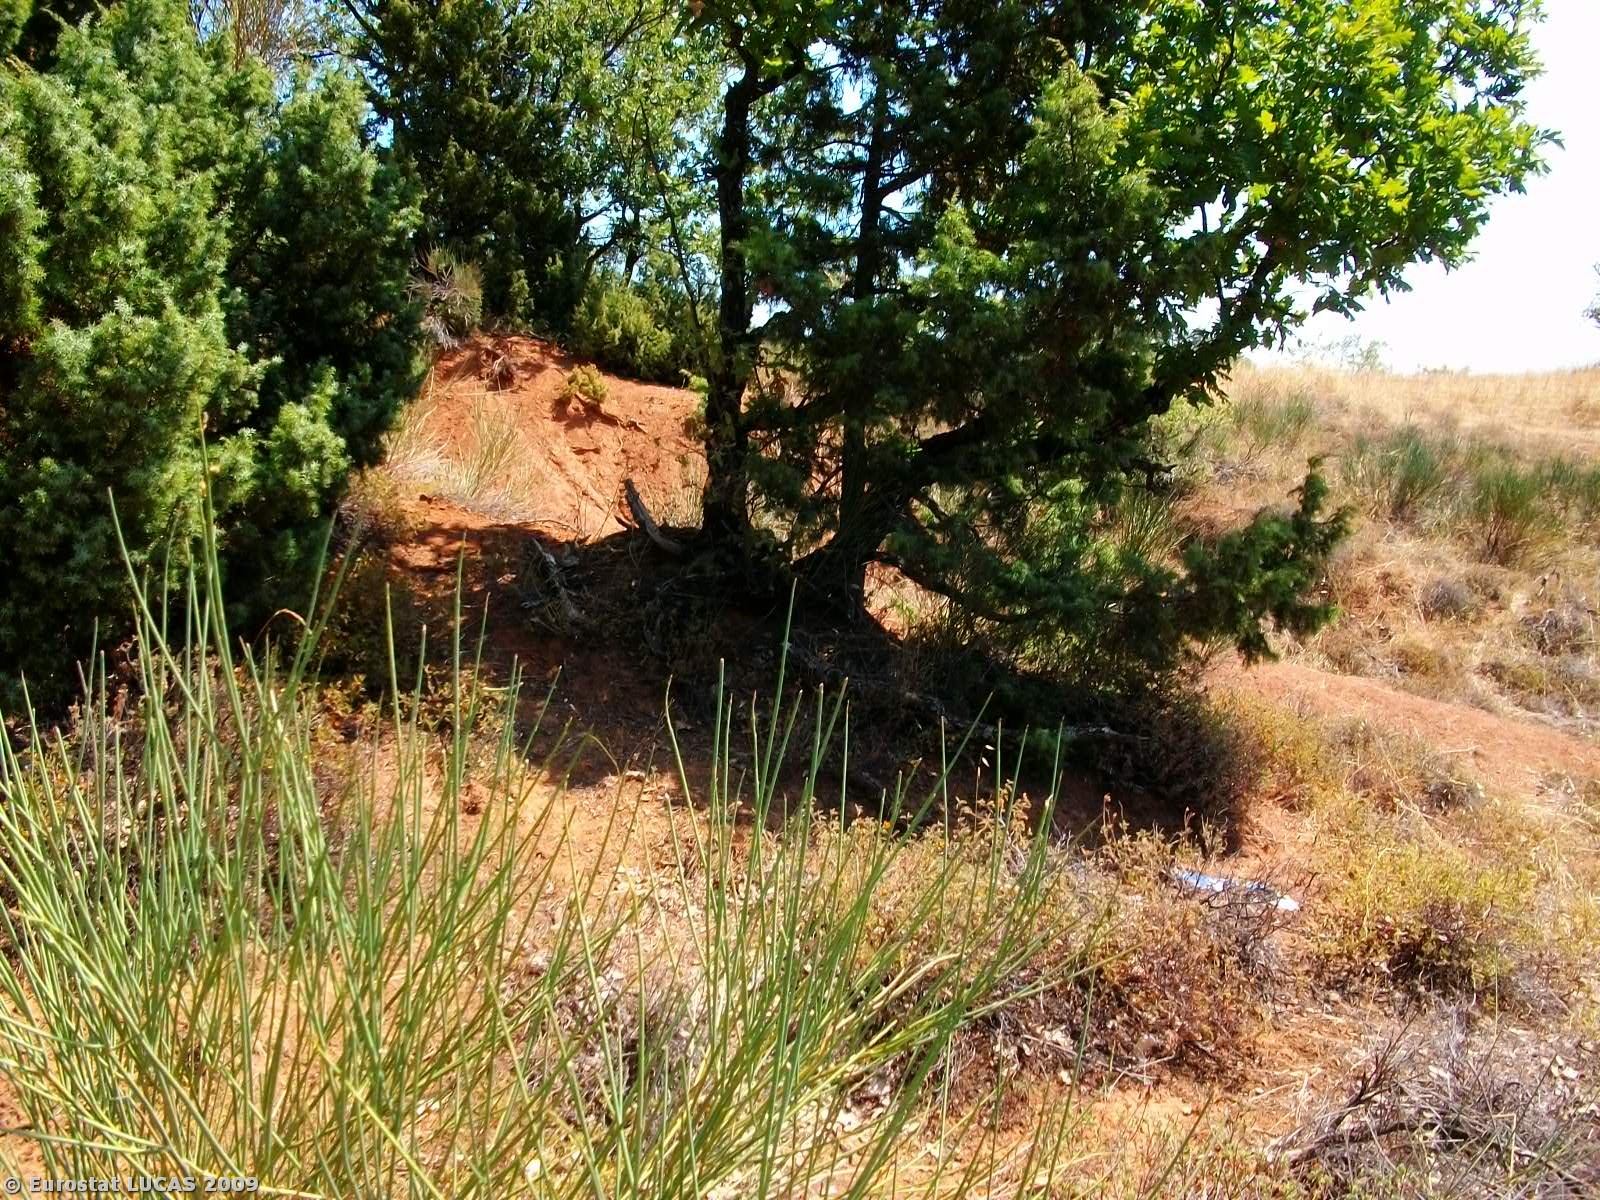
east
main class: Woodland
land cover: Mixed woodland
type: coniferous forest of the mediterranean region
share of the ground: 50 - 75 %
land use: Forestry
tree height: > 5 m
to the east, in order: Mixed woodland; Grassland with sparse tree/shrub cover; Mixed woodland; Inland running water; Mixed woodland; Grassland without tree/shrub cover; Mixed woodland; Grassland without tree/shrub cover
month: August
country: GR
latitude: 38.7258
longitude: 22.4124
